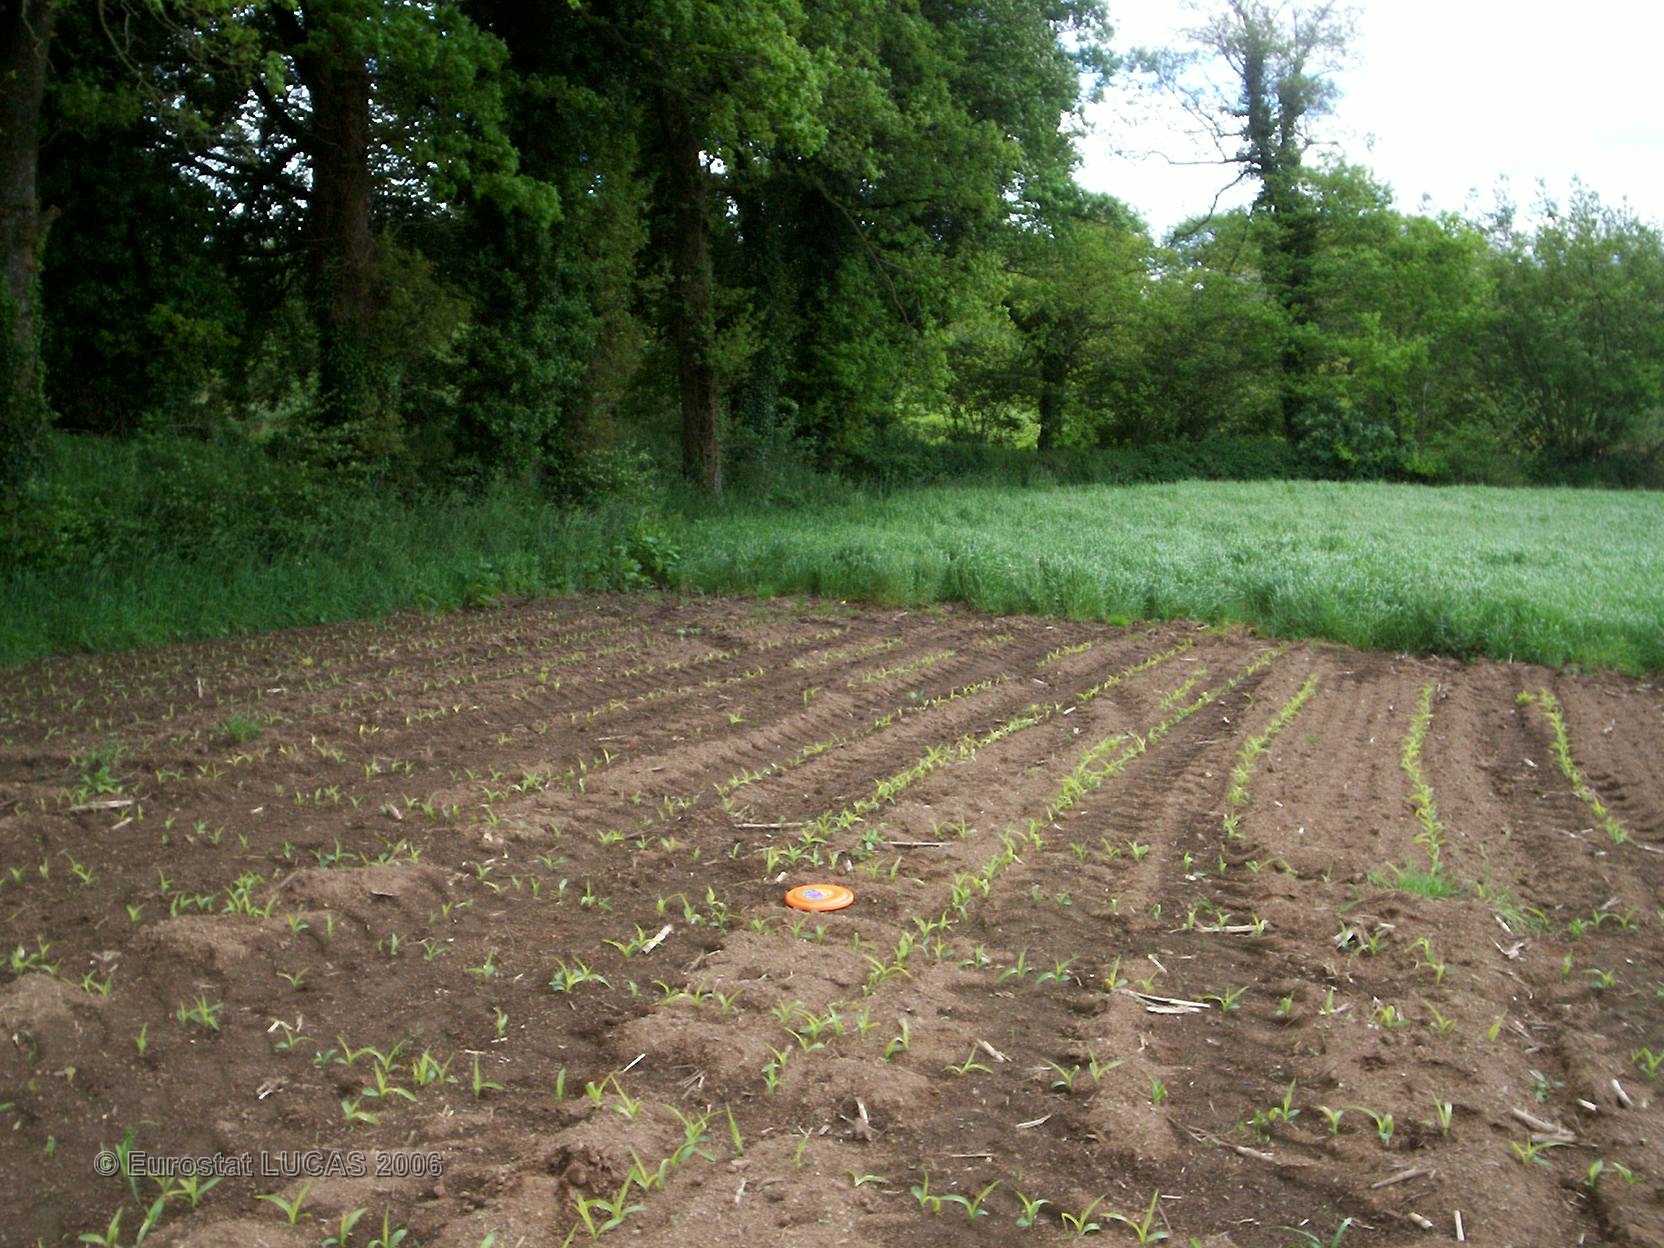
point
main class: Cropland
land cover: Maize
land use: Agriculture (excluding fallow land and kitchen gardens)
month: May
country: FR
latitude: 48.3948
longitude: -3.0220
